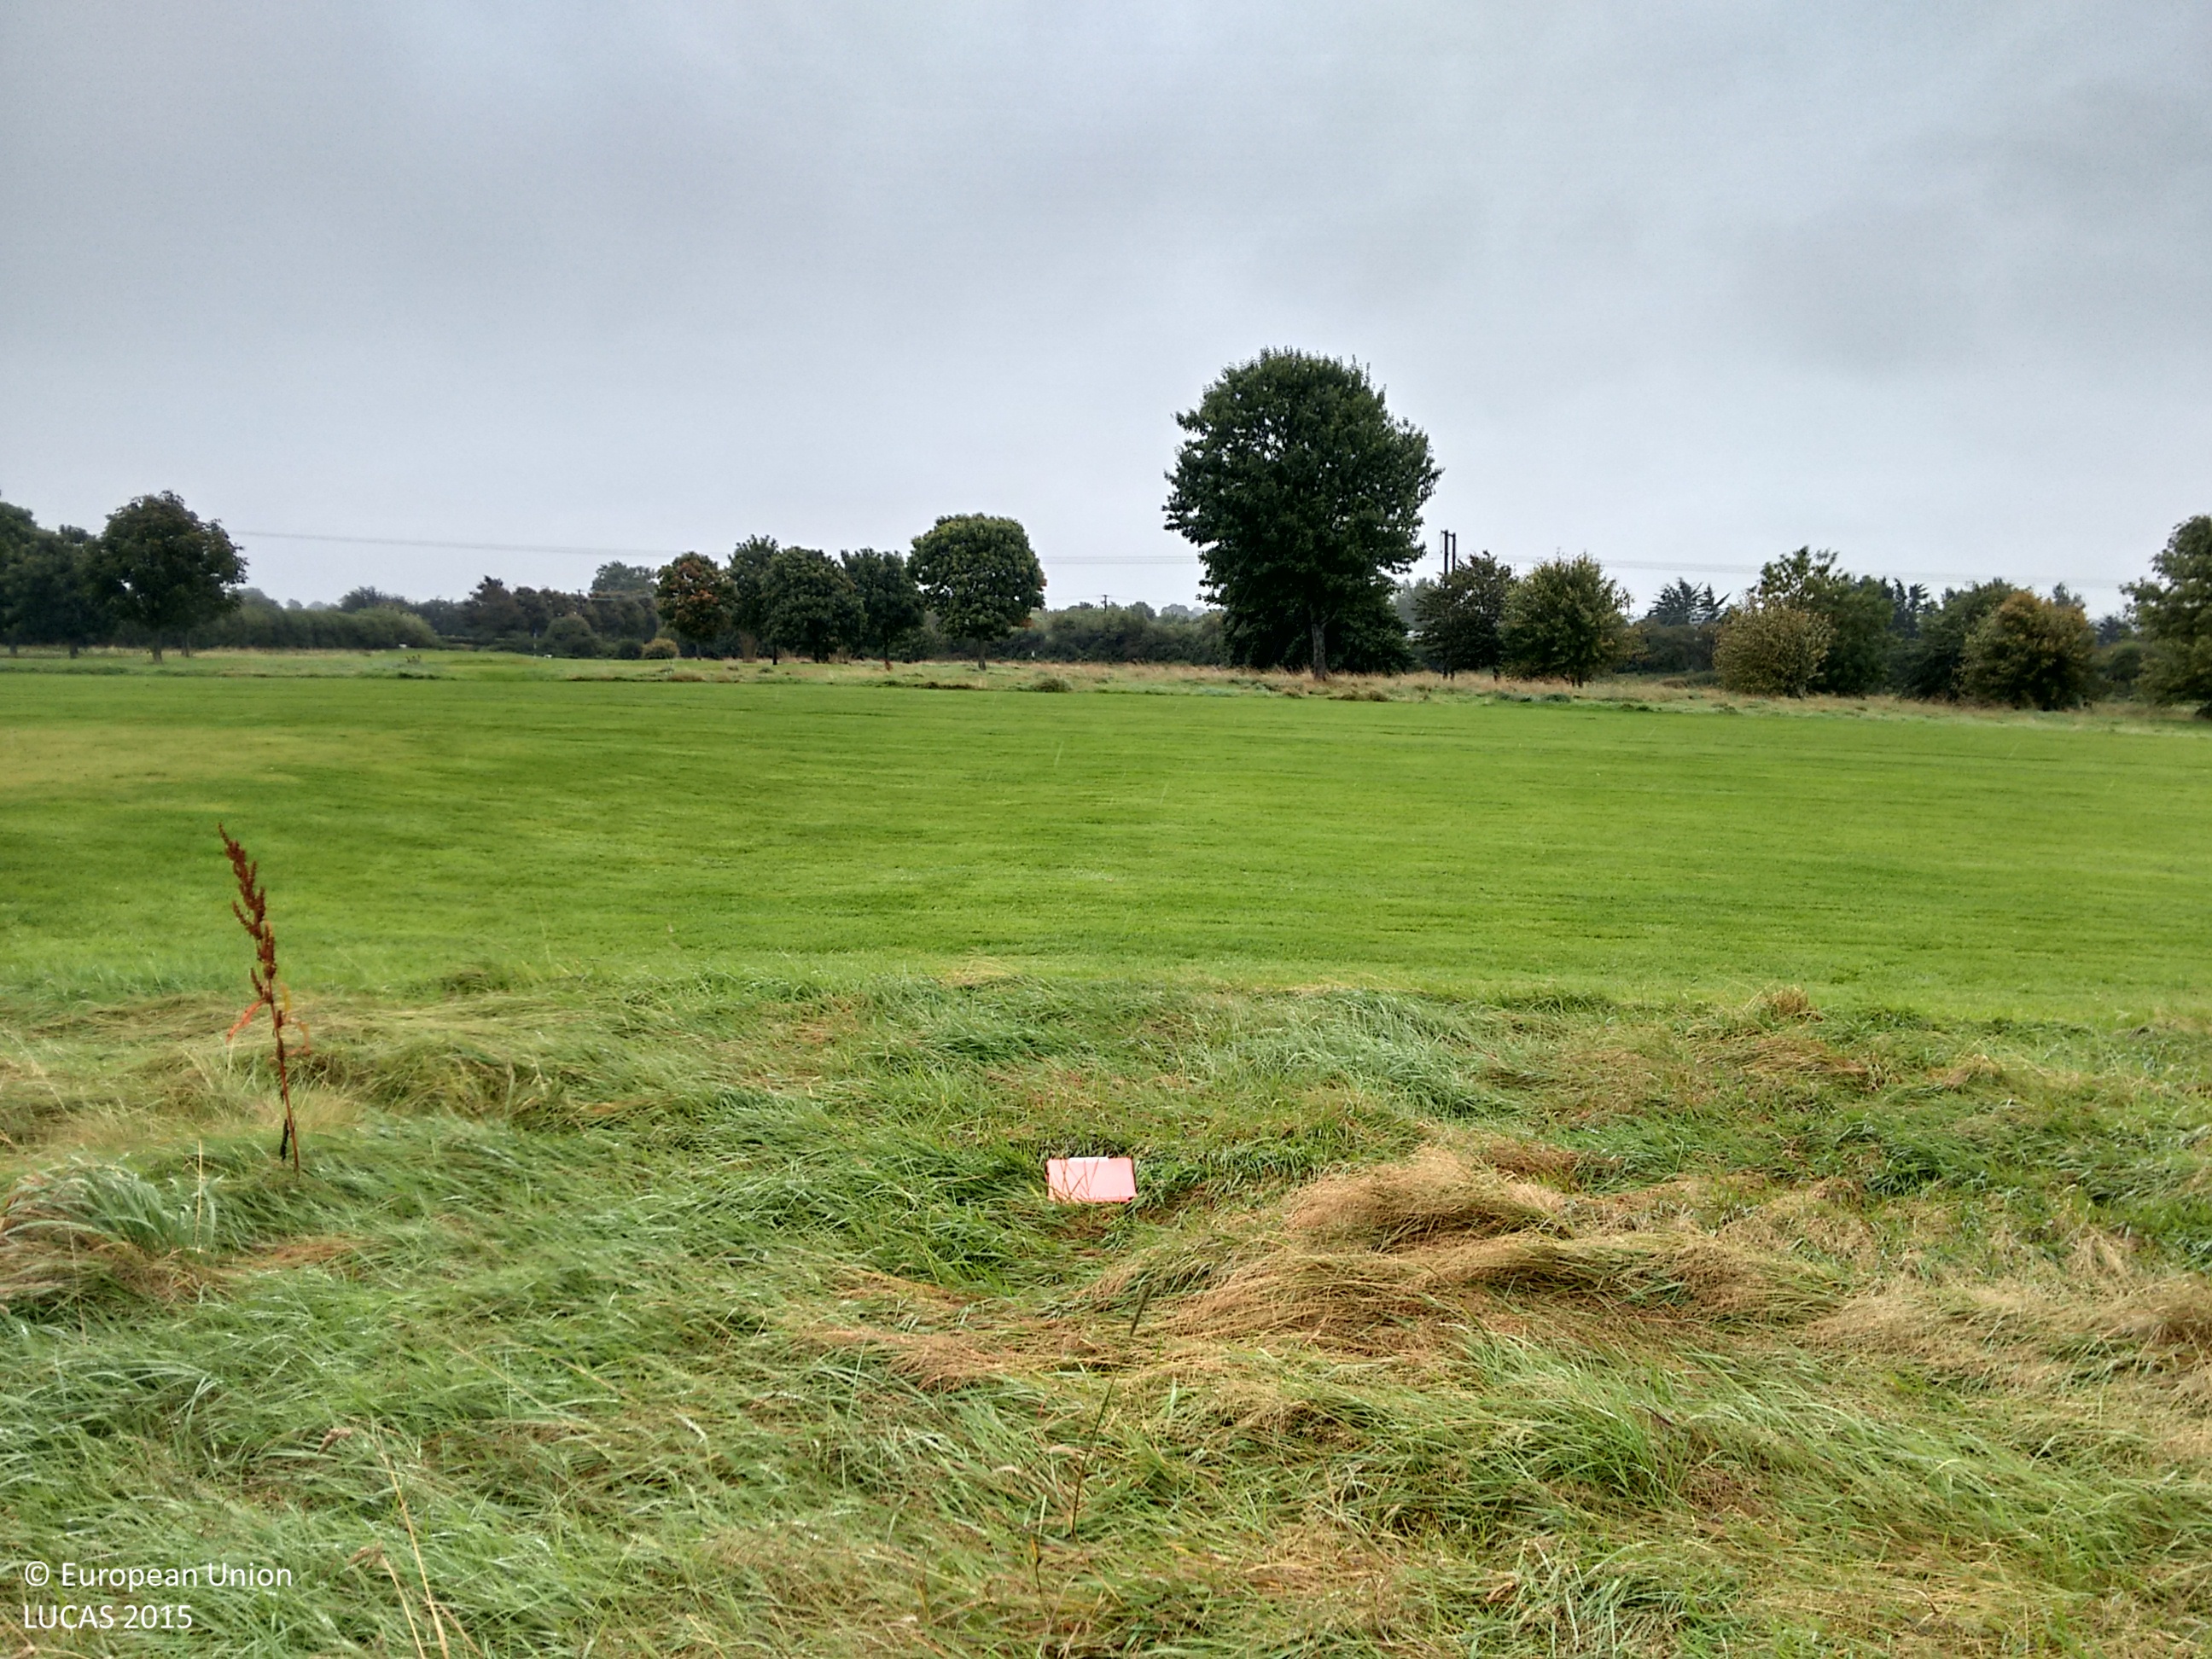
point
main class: Grassland
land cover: Grassland without tree/shrub cover
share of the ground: > 75 %
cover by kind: herbaceous plants 100 %
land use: Sport
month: September
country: IE
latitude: 52.6442
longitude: -8.5978
